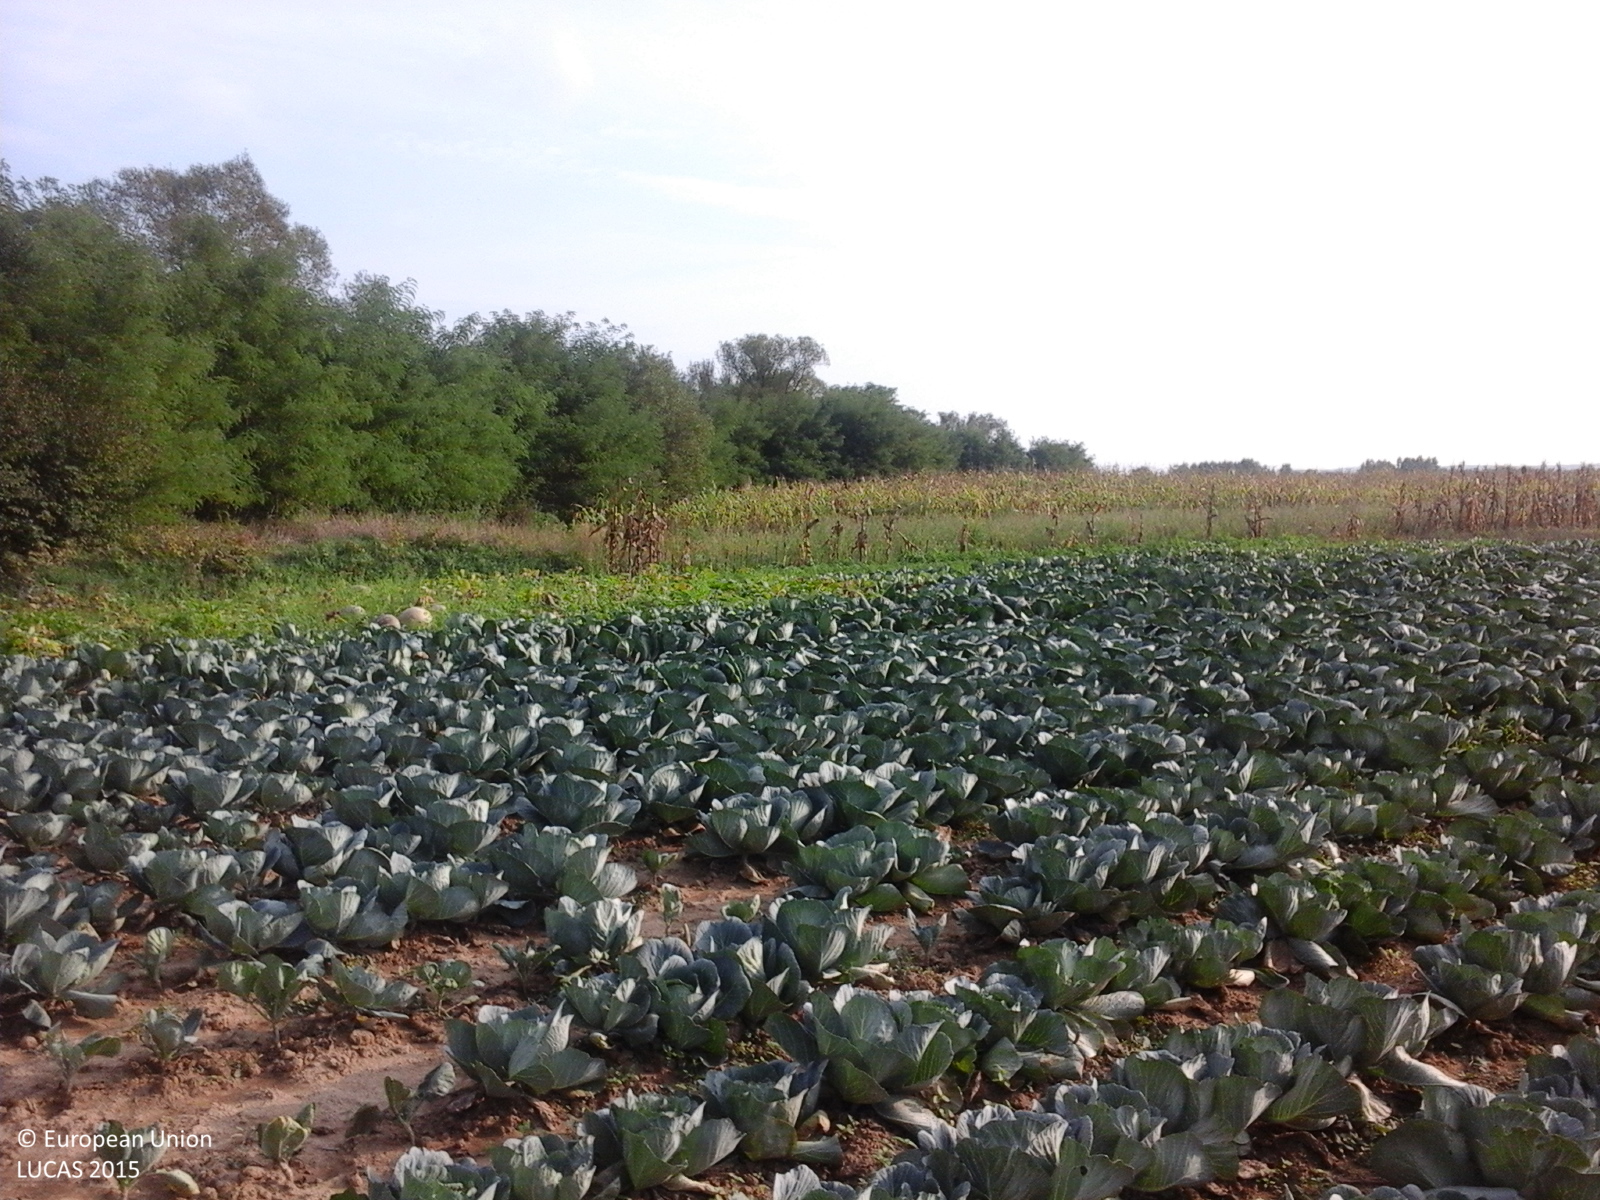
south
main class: Cropland
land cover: Other fresh vegetables
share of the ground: > 75 %
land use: Agriculture (excluding fallow land and kitchen gardens)
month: September
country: RO
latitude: 45.7924
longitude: 22.0694
